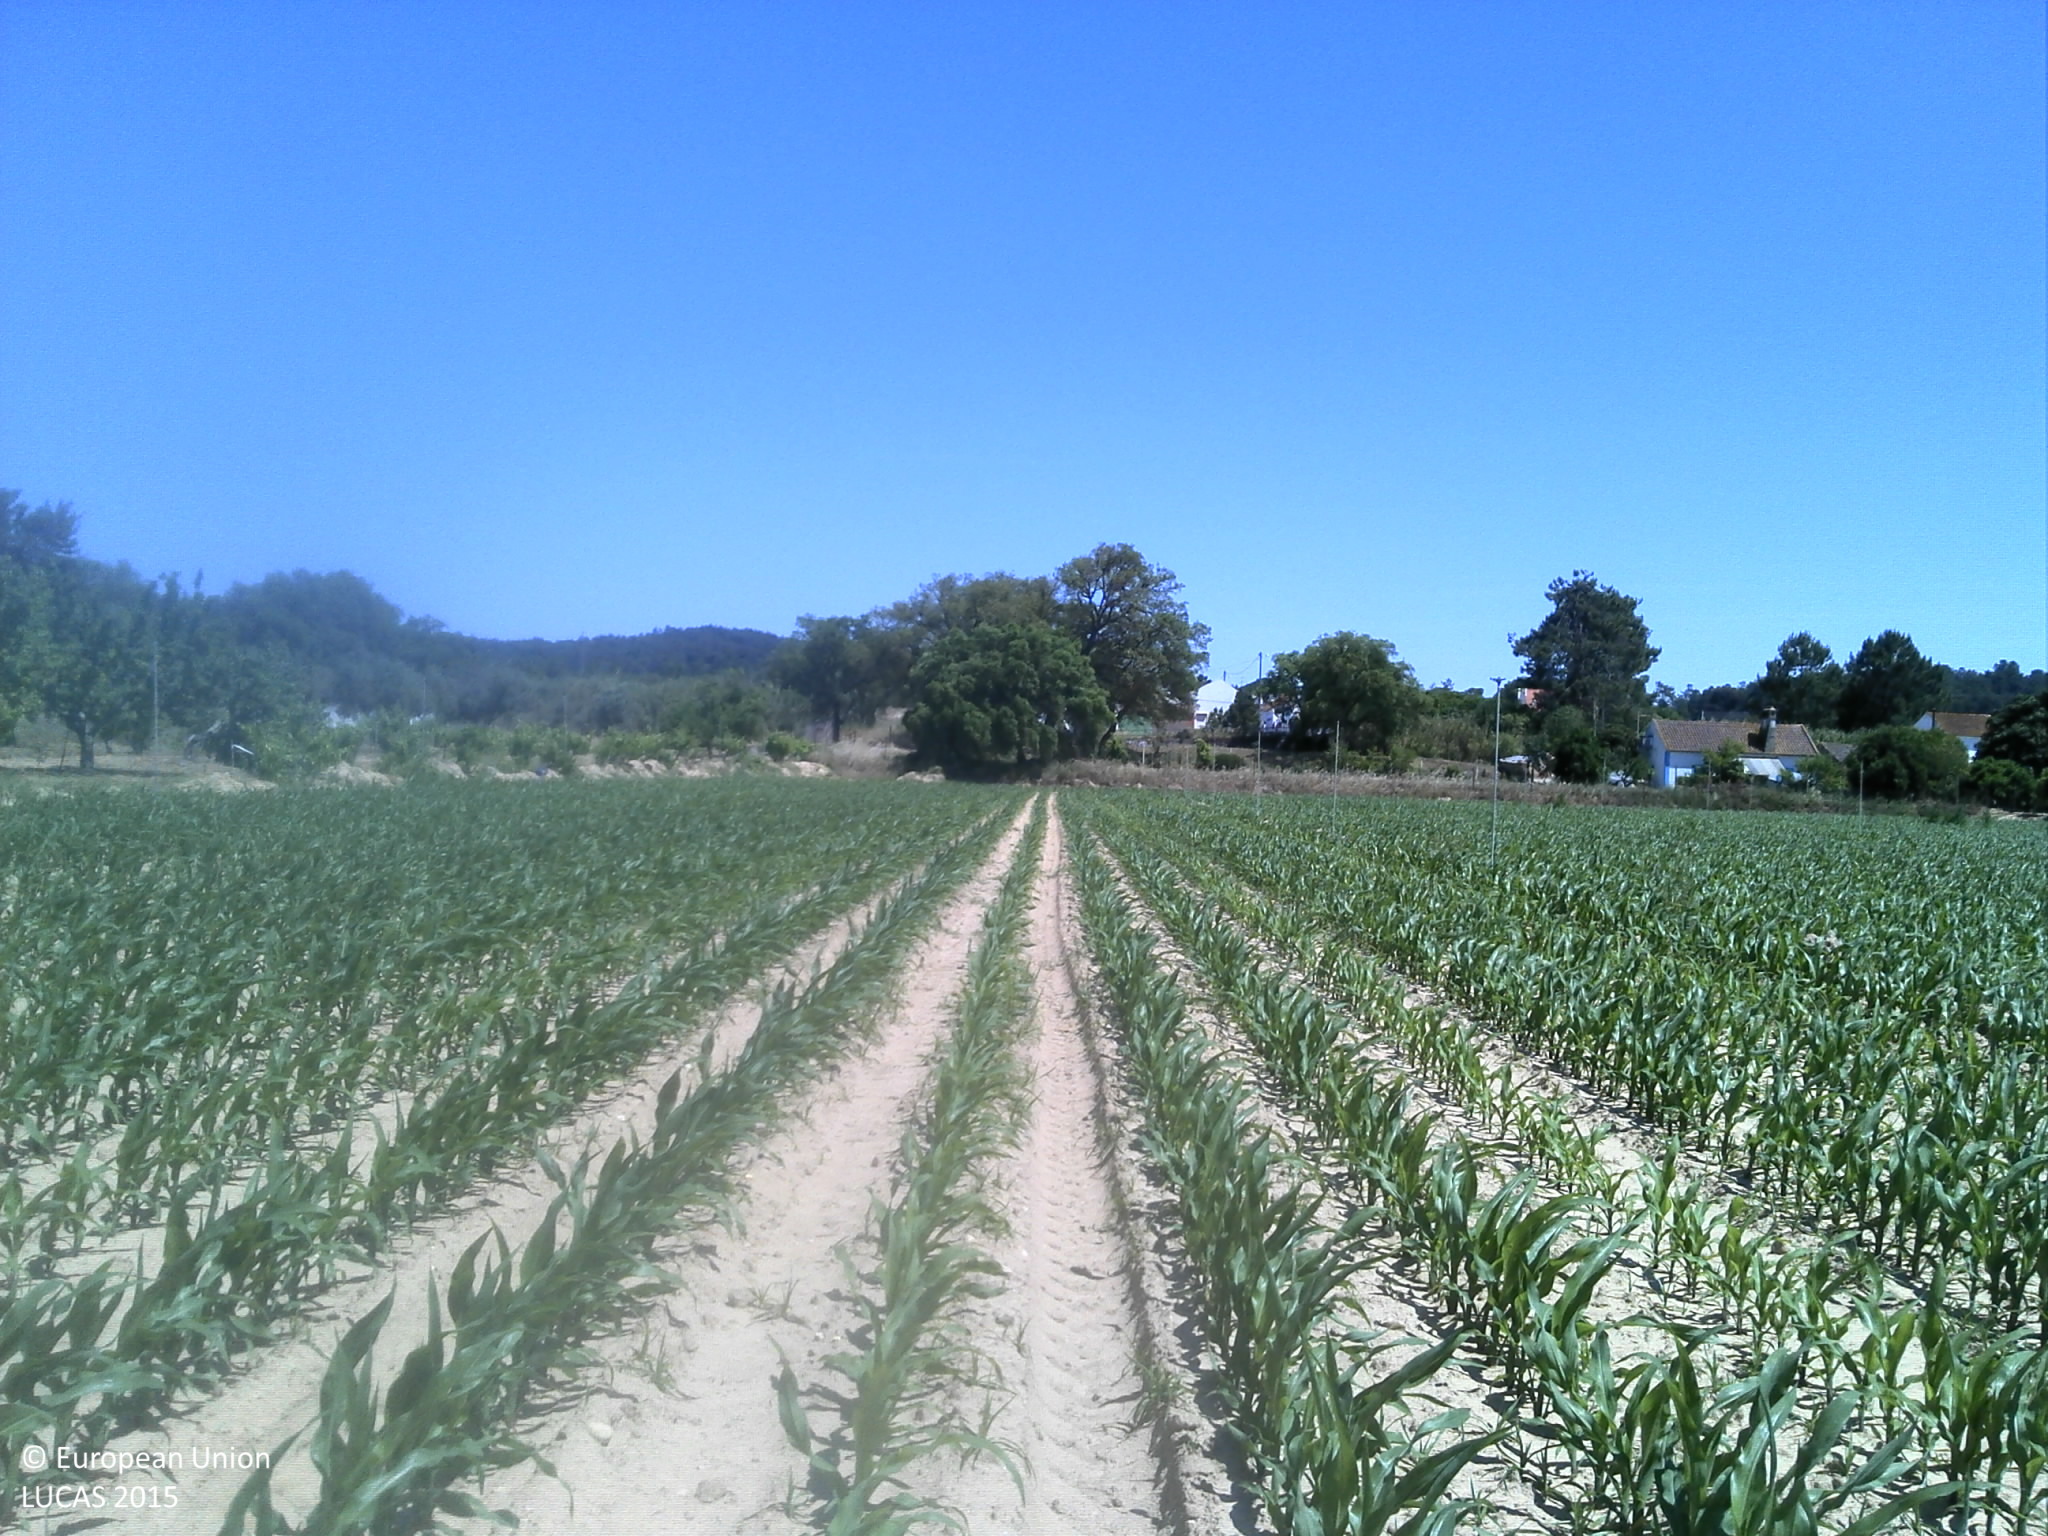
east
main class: Cropland
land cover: Maize
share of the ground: 10 - 25 %
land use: Agriculture (excluding fallow land and kitchen gardens)
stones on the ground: < 10 %
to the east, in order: Maize; Vineyards; Spontaneously vegetated surfaces; Vineyards; Olive groves; Spontaneously vegetated surfaces; Dry stone walls; Spontaneously vegetated surfaces; Conifer hedges; Electric lines; Dry stone walls; Tracks; Grass margins; Shruby margins; Rivers and streams; Shruby margins; Broadleaved woodland; Pine dominated coniferous woodland
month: May
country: PT
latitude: 39.4106
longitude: -8.4308
